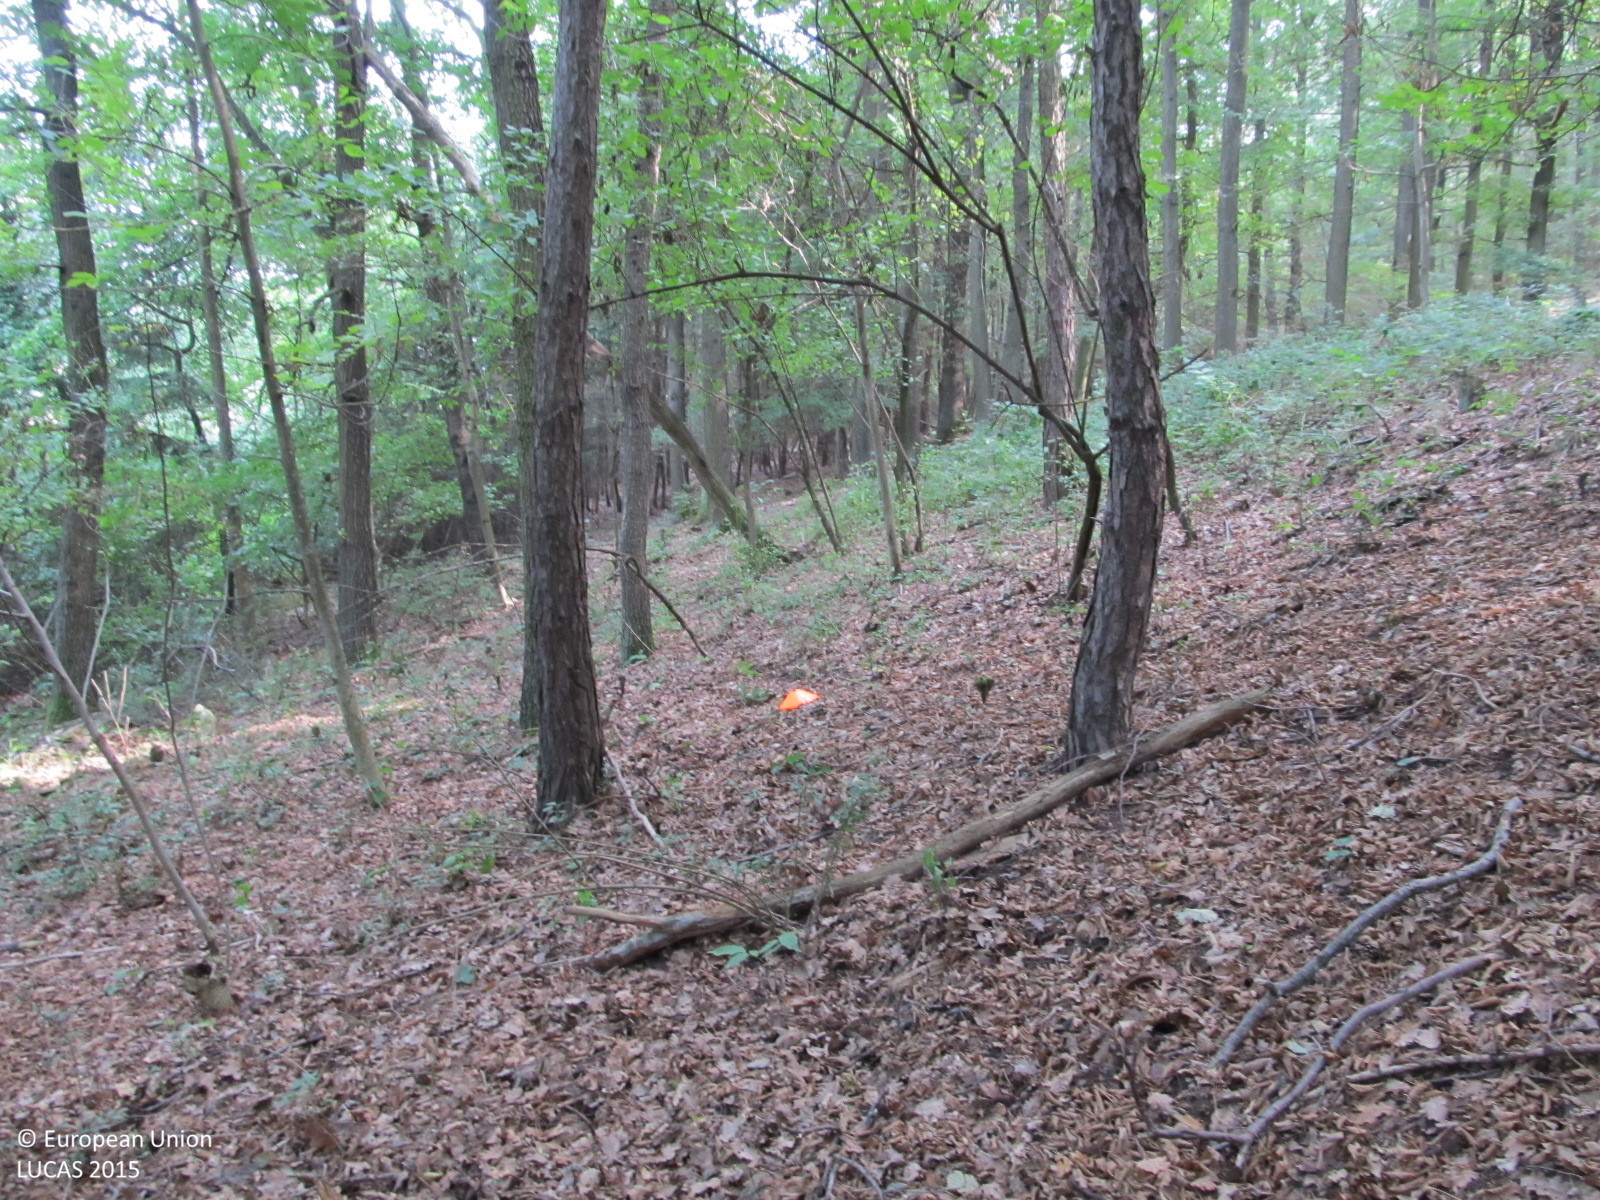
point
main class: Woodland
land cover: Other mixed woodland
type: hemiboreal forest and nemoral coniferous forest and mixed broadleaved-coniferous forest
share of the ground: > 75 %
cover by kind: broadleaved forest trees 60 %, coniferous forest trees 20 %, herbaceous plants 10 %, unconsolidated bare surface 10 %
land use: Forestry
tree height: > 5 m
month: September
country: AT
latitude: 48.3323
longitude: 15.6279
